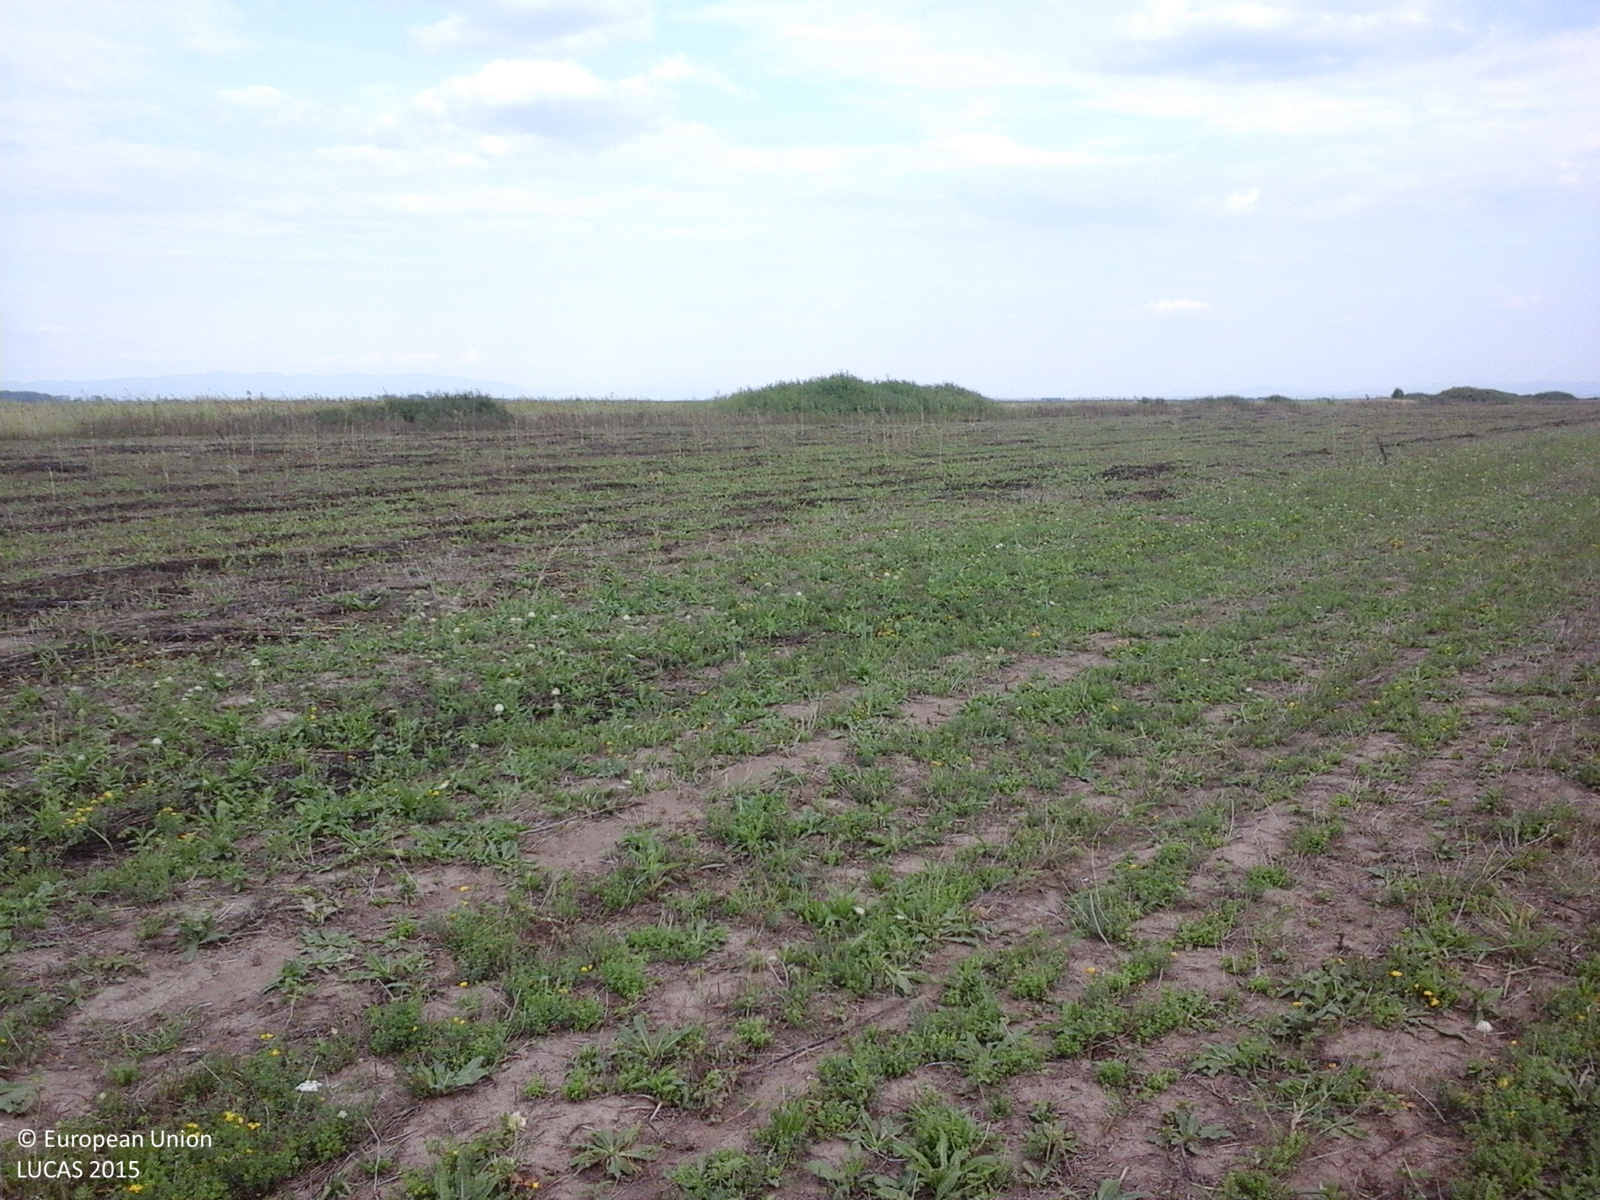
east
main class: Grassland
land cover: Spontaneously vegetated surfaces
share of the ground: > 75 %
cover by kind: herbaceous plants 100 %
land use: Fallow land
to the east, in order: Spontaneously vegetated surfaces; Abandoned hedges; Ditches and canals; Abandoned hedges; Spontaneously vegetated surfaces; Common wheat; Maize
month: August
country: RO
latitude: 46.3908
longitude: 21.5993
